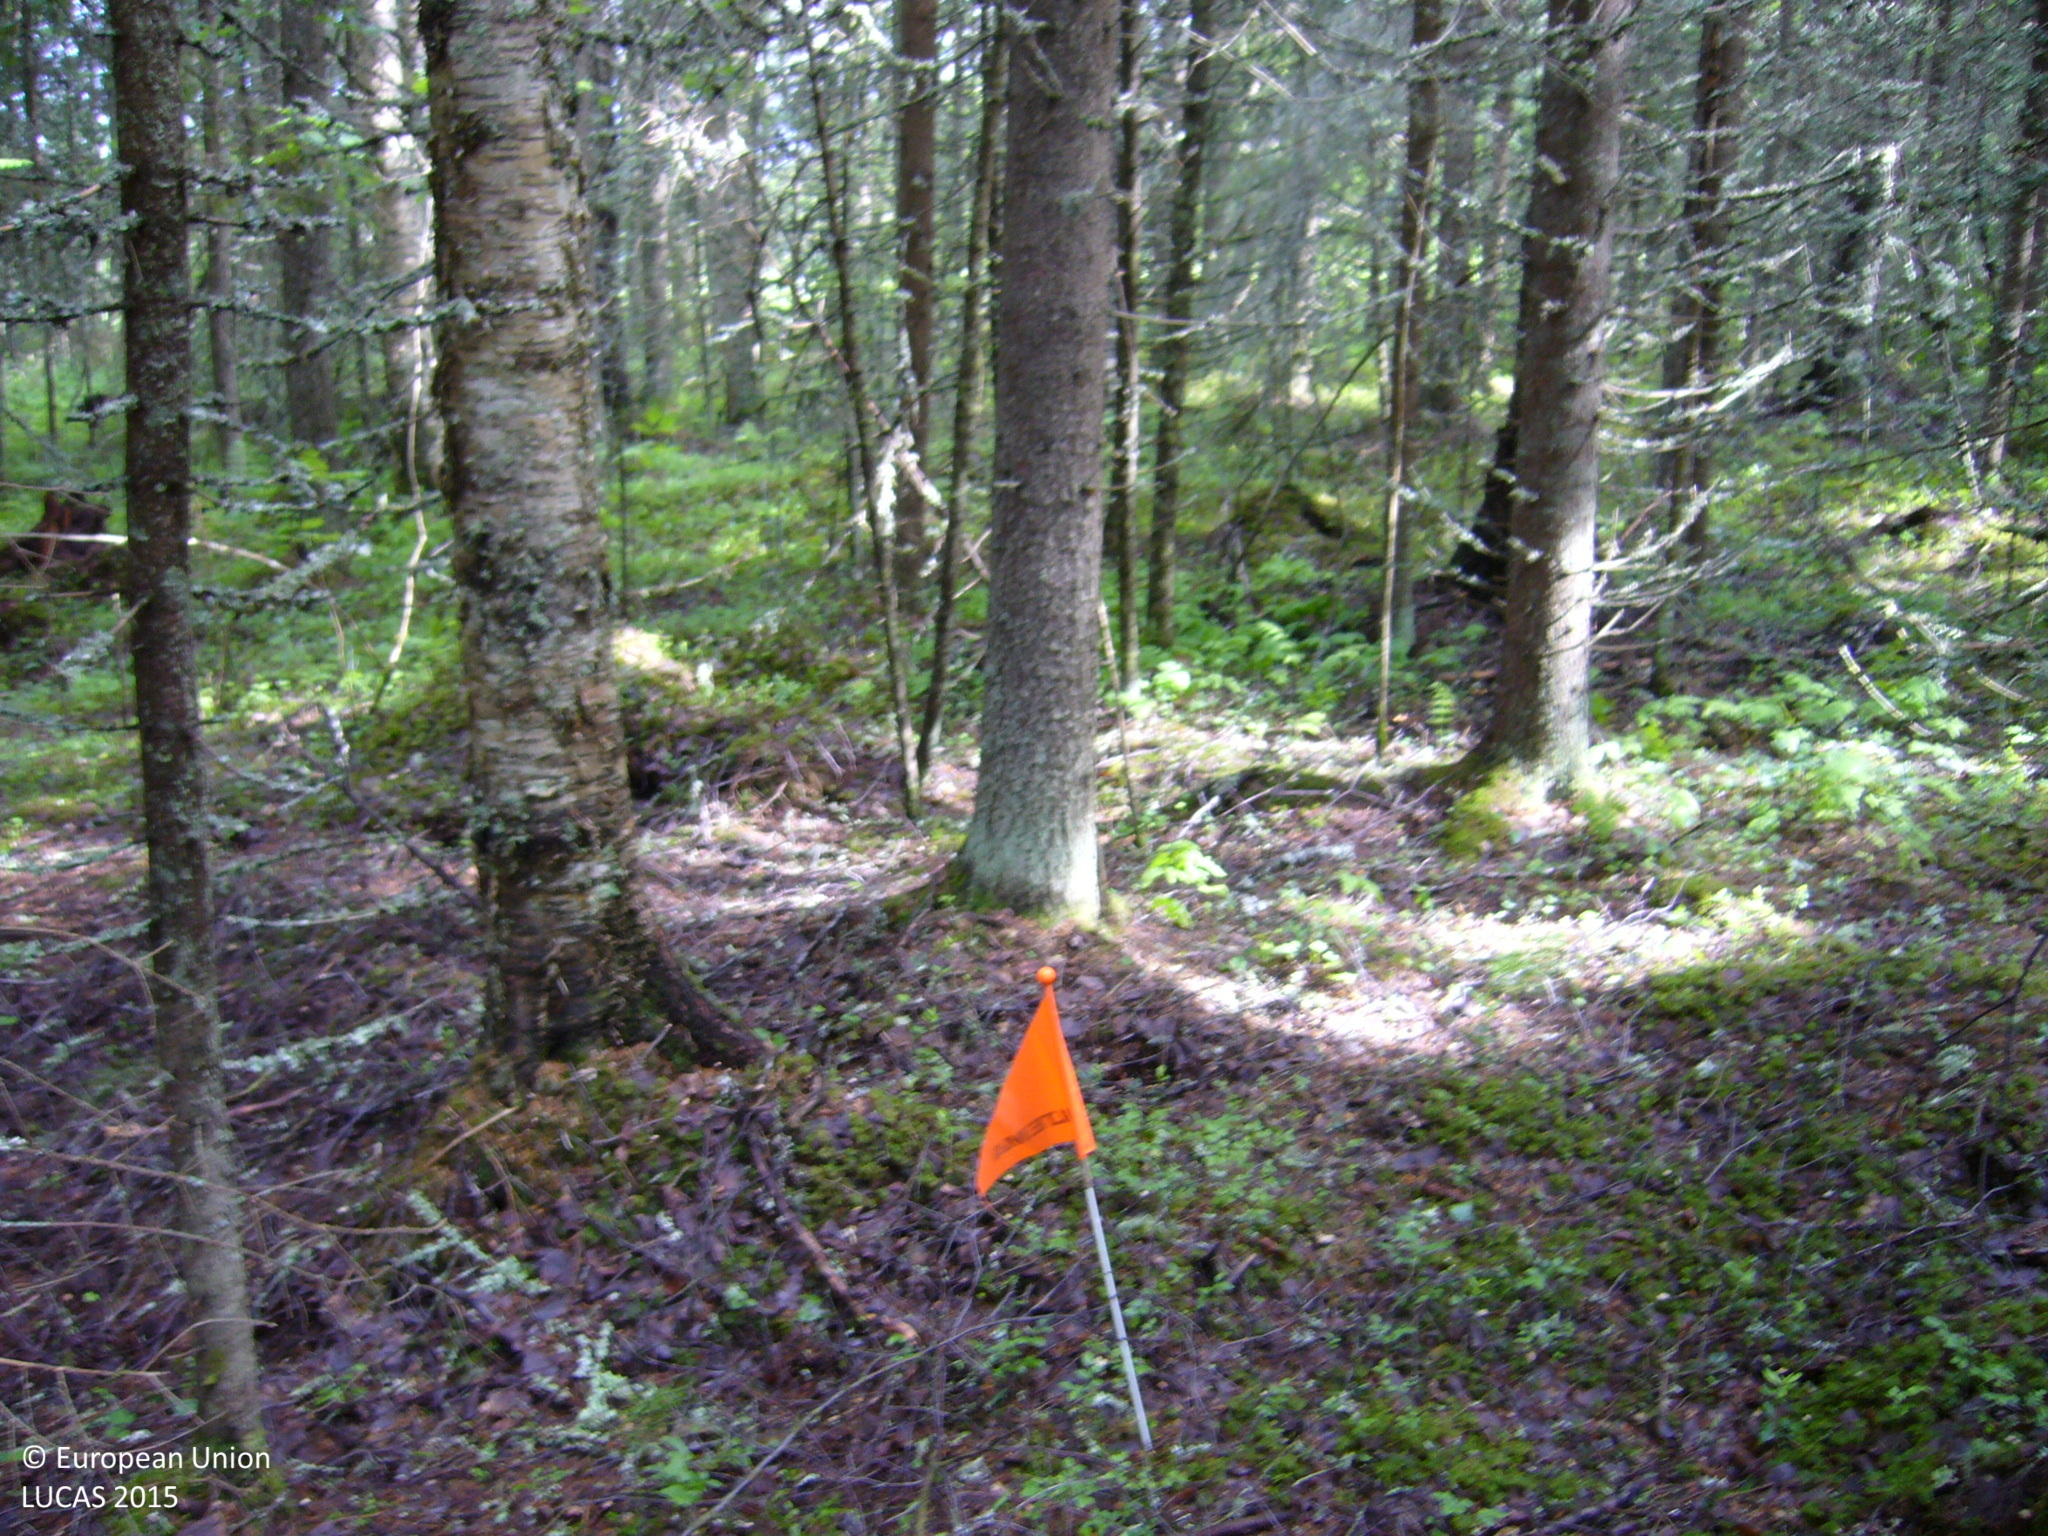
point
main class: Woodland
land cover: Spruce dominated coniferous woodland
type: boreal forest
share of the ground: > 75 %
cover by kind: coniferous forest trees 85 %, broadleaved forest trees 10 %, shrubs 5 %
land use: Forestry
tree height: > 5 m
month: June
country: FI
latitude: 63.7493
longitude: 26.3100
